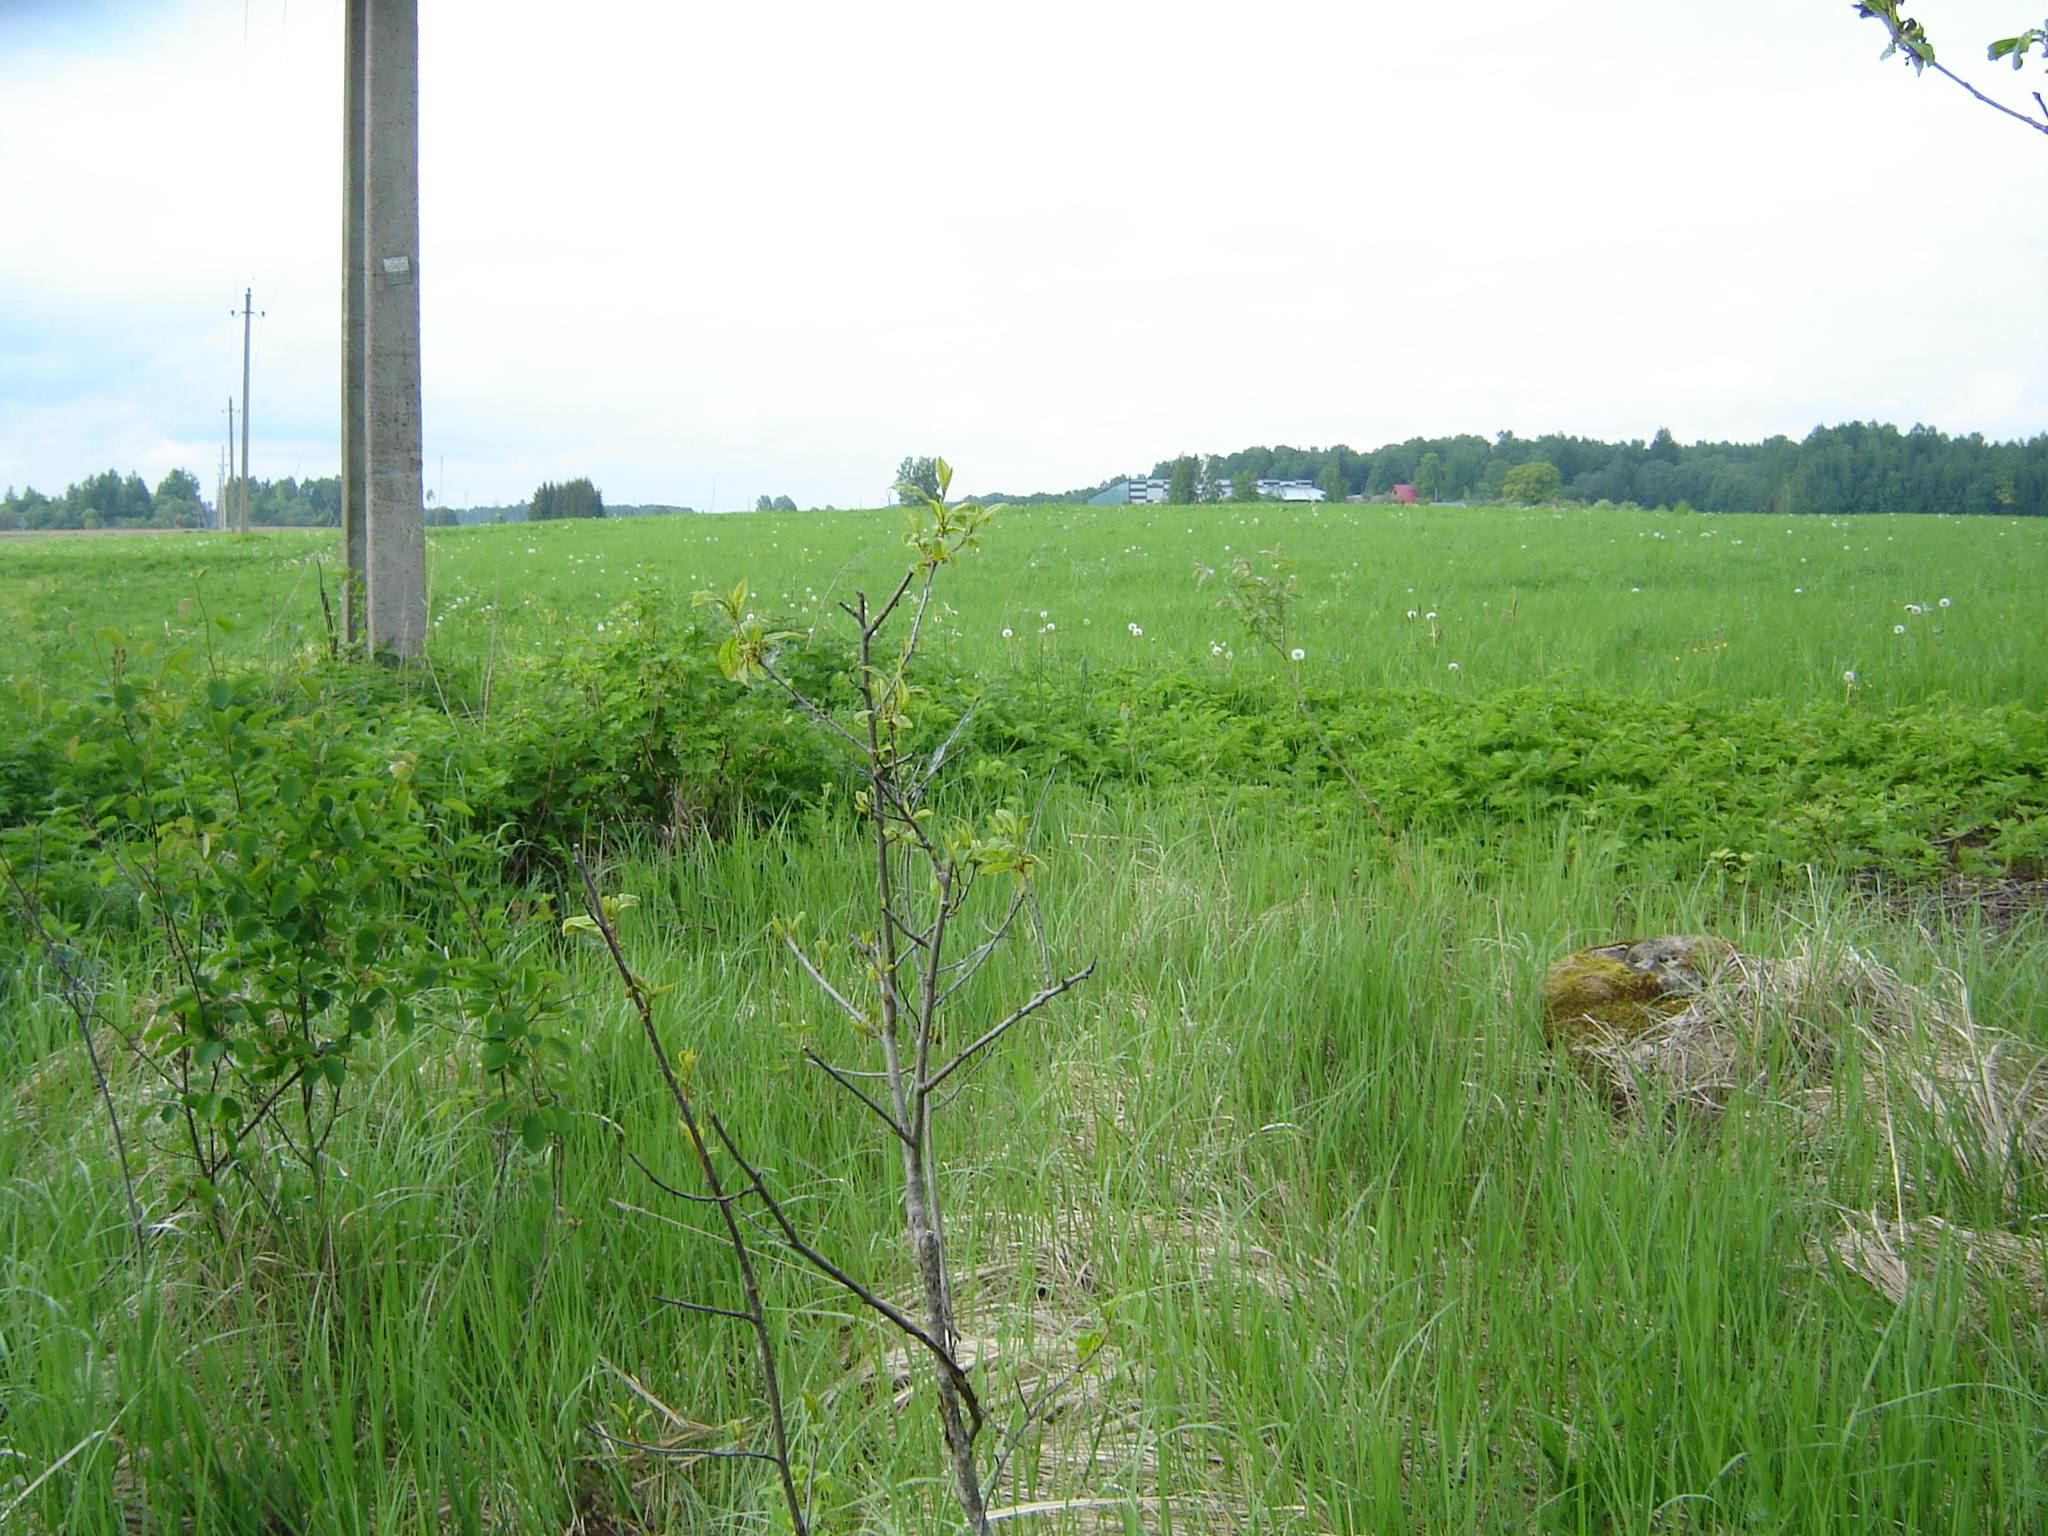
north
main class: Grassland
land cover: Grassland with sparse tree/shrub cover
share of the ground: > 75 %
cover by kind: herbaceous plants 95 %, broadleaved forest trees 5 %
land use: Semi-natural and natural areas not in use
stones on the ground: < 10 %
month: May
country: LT
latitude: 55.9980
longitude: 25.4331
